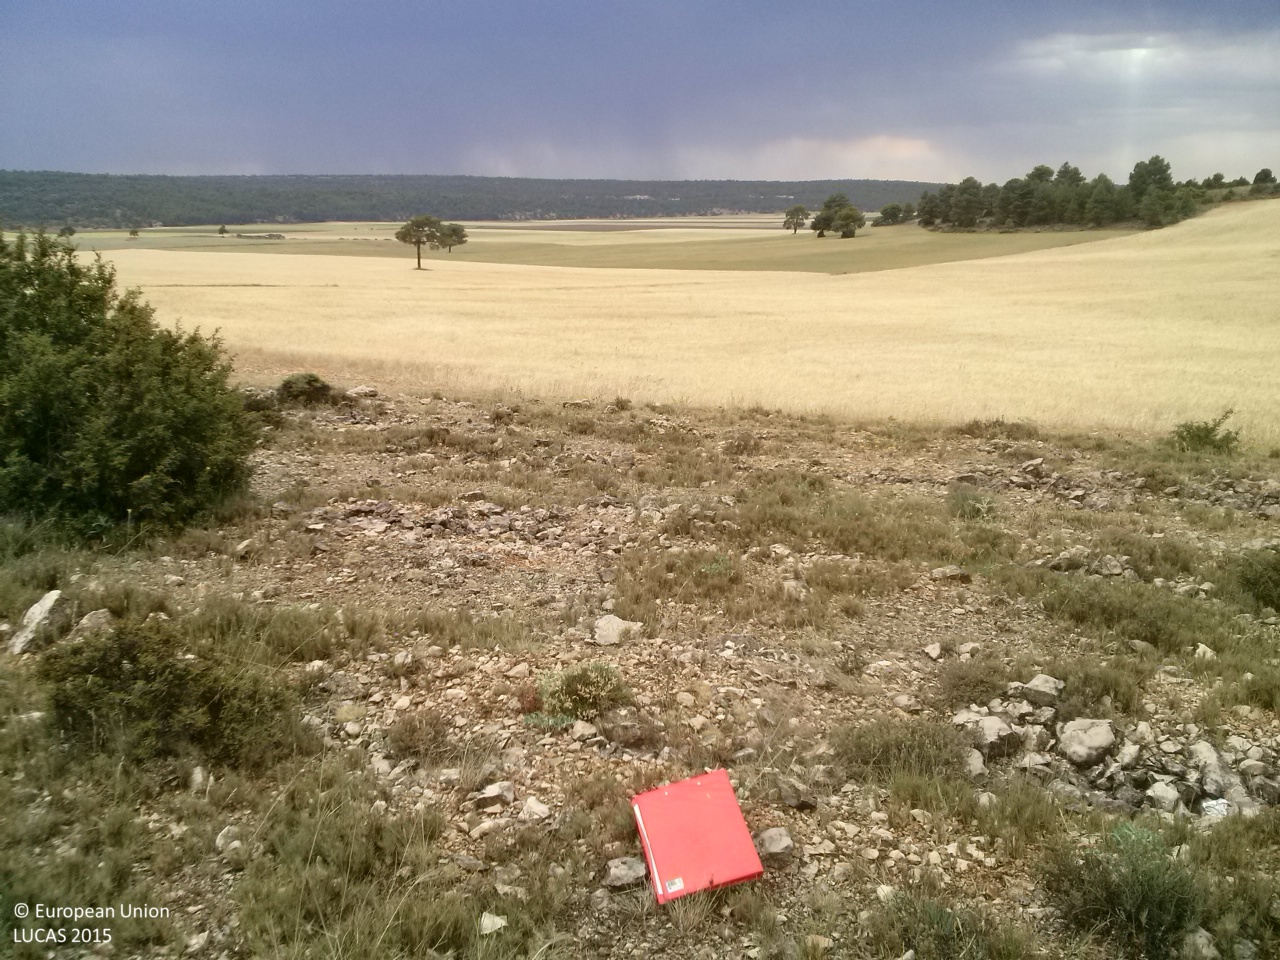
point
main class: Shrubland
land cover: Shrubland without tree cover
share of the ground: 10 - 25 %
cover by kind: herbaceous plants 40 %, unconsolidated bare surface 40 %, shrubs 20 %
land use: Agriculture (excluding fallow land and kitchen gardens)
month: June
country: ES
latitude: 39.9254
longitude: -1.8880
